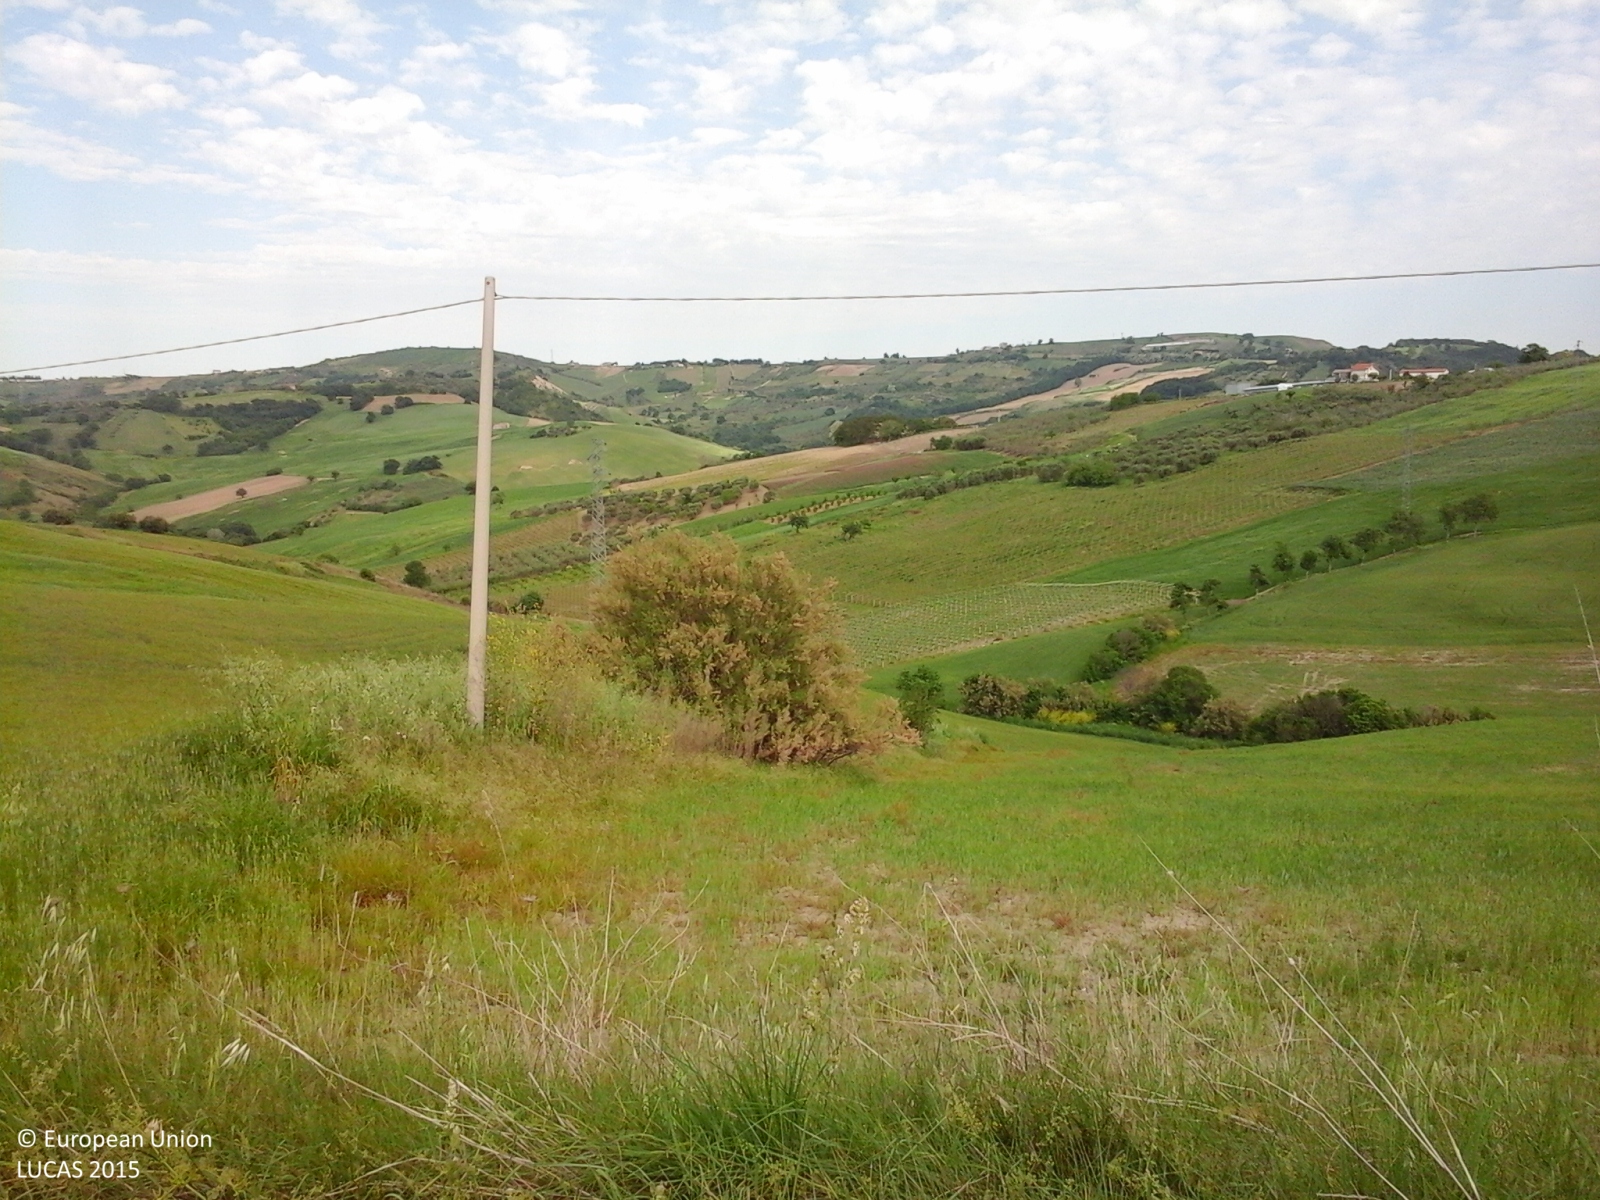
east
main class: Grassland
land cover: Grassland without tree/shrub cover
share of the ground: 25 - 50 %
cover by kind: herbaceous plants 100 %
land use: Semi-natural and natural areas not in use
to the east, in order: Grassland without tree/shrub cover; Paved roads, cycling and walking lanes; Mixed cereals for fodder; Electric lines; Grass margins; Durum wheat; Electric lines; Durum wheat
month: May
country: IT
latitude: 42.0604
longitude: 14.6139
